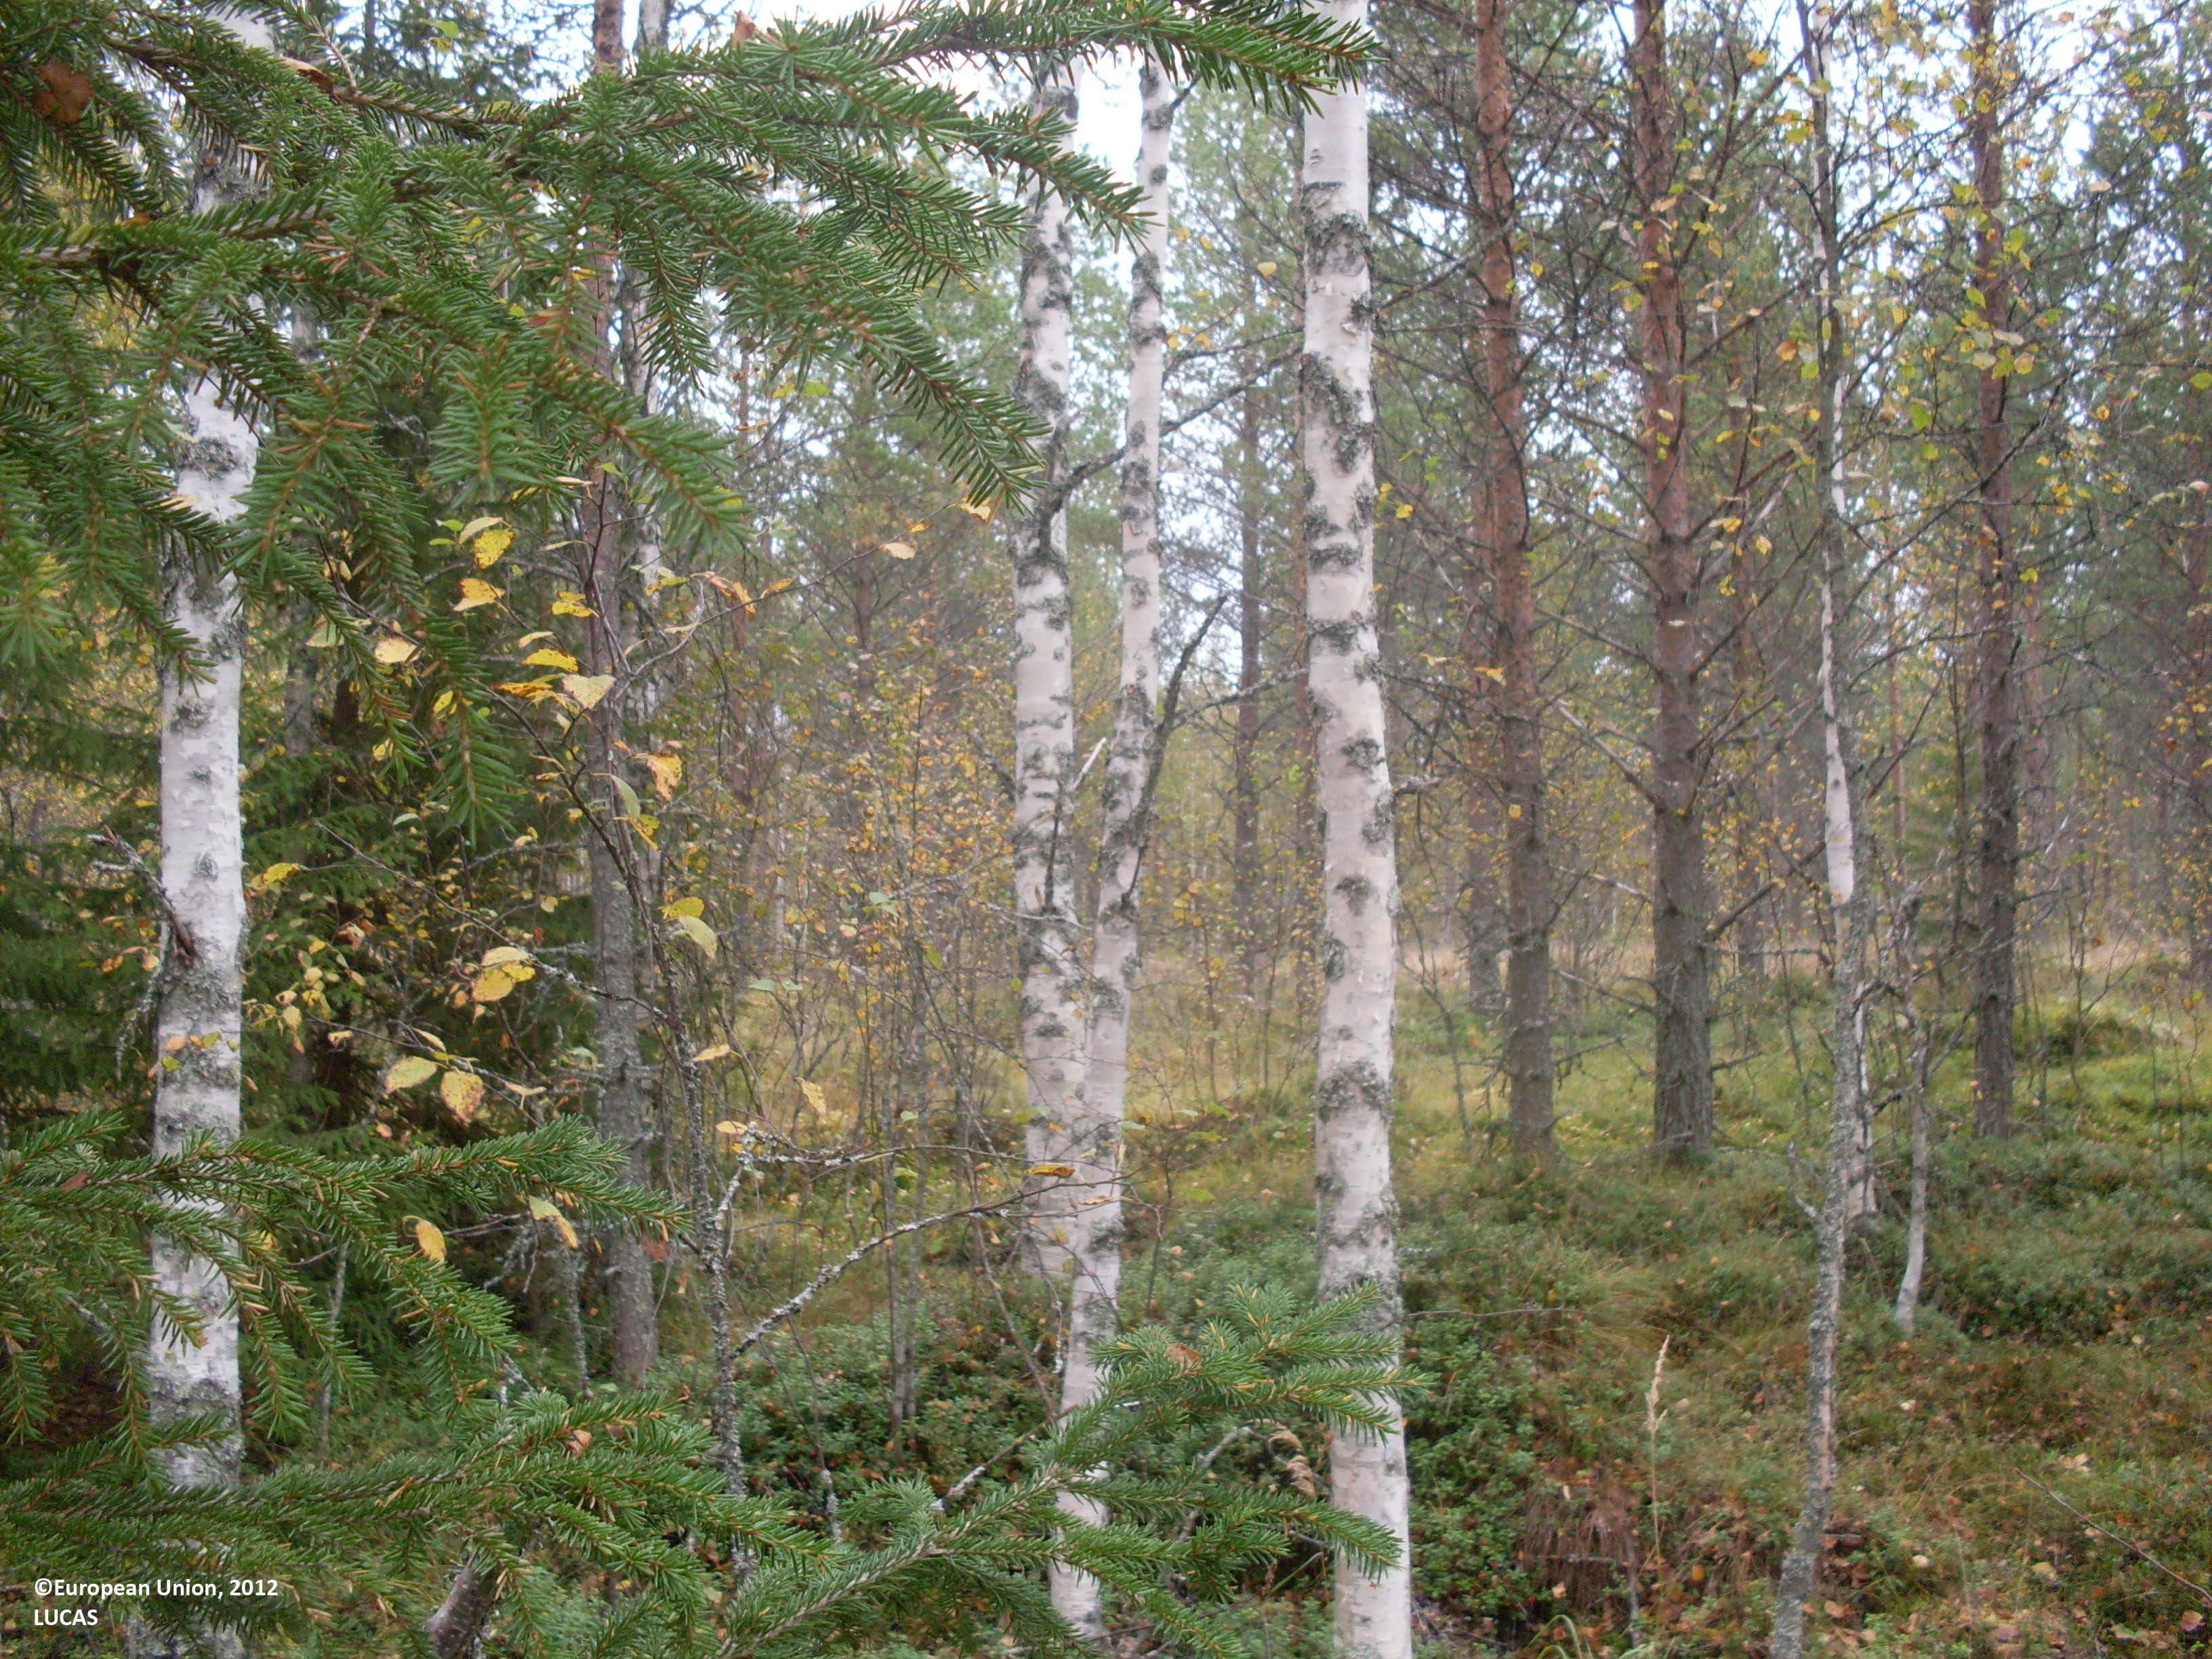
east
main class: Woodland
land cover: Other mixed woodland
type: boreal forest
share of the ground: > 75 %
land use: Forestry
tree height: > 5 m
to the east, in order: Other mixed woodland; Ditches and canals; Other mixed woodland; Ditches and canals; Other mixed woodland; Ditches and canals; Other mixed woodland
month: September
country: FI
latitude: 63.9928
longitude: 29.4959
